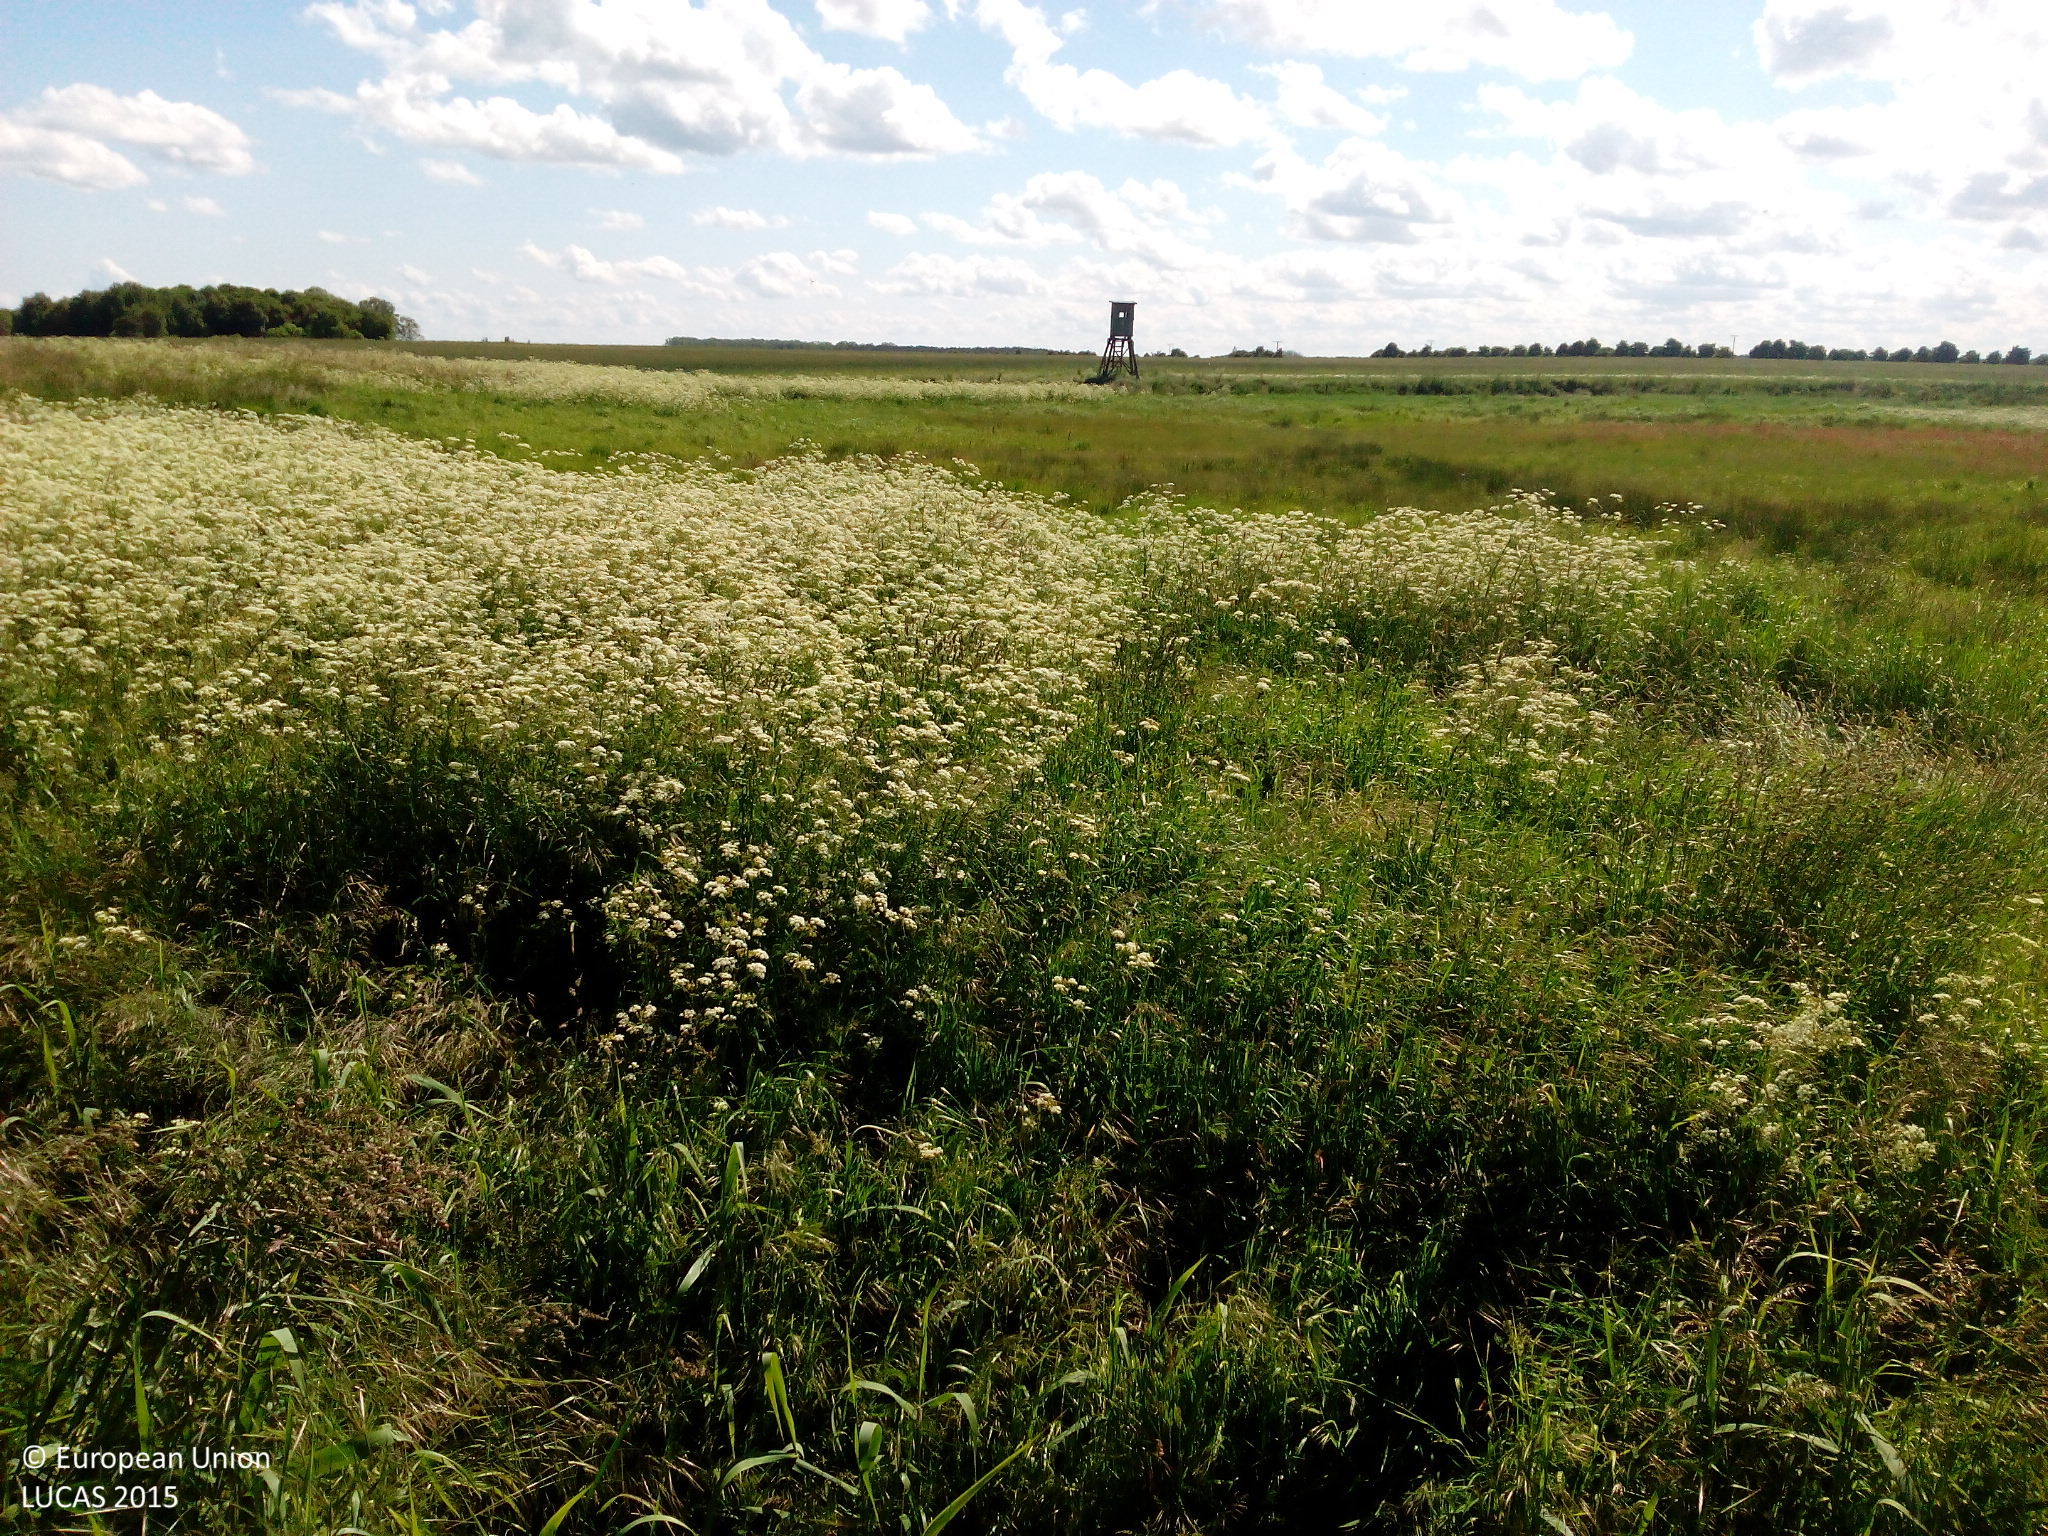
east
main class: Cropland
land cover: Rape and turnip rape
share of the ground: > 75 %
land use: Agriculture (excluding fallow land and kitchen gardens)
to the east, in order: Rape and turnip rape; Shruby margins; Ditches and canals; Shrubland without tree cover; Grassland without tree/shrub cover; Shrubland without tree cover; Grassland without tree/shrub cover; Ditches and canals; Grassland without tree/shrub cover; Rye
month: June
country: DE
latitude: 53.3189
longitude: 12.6564
